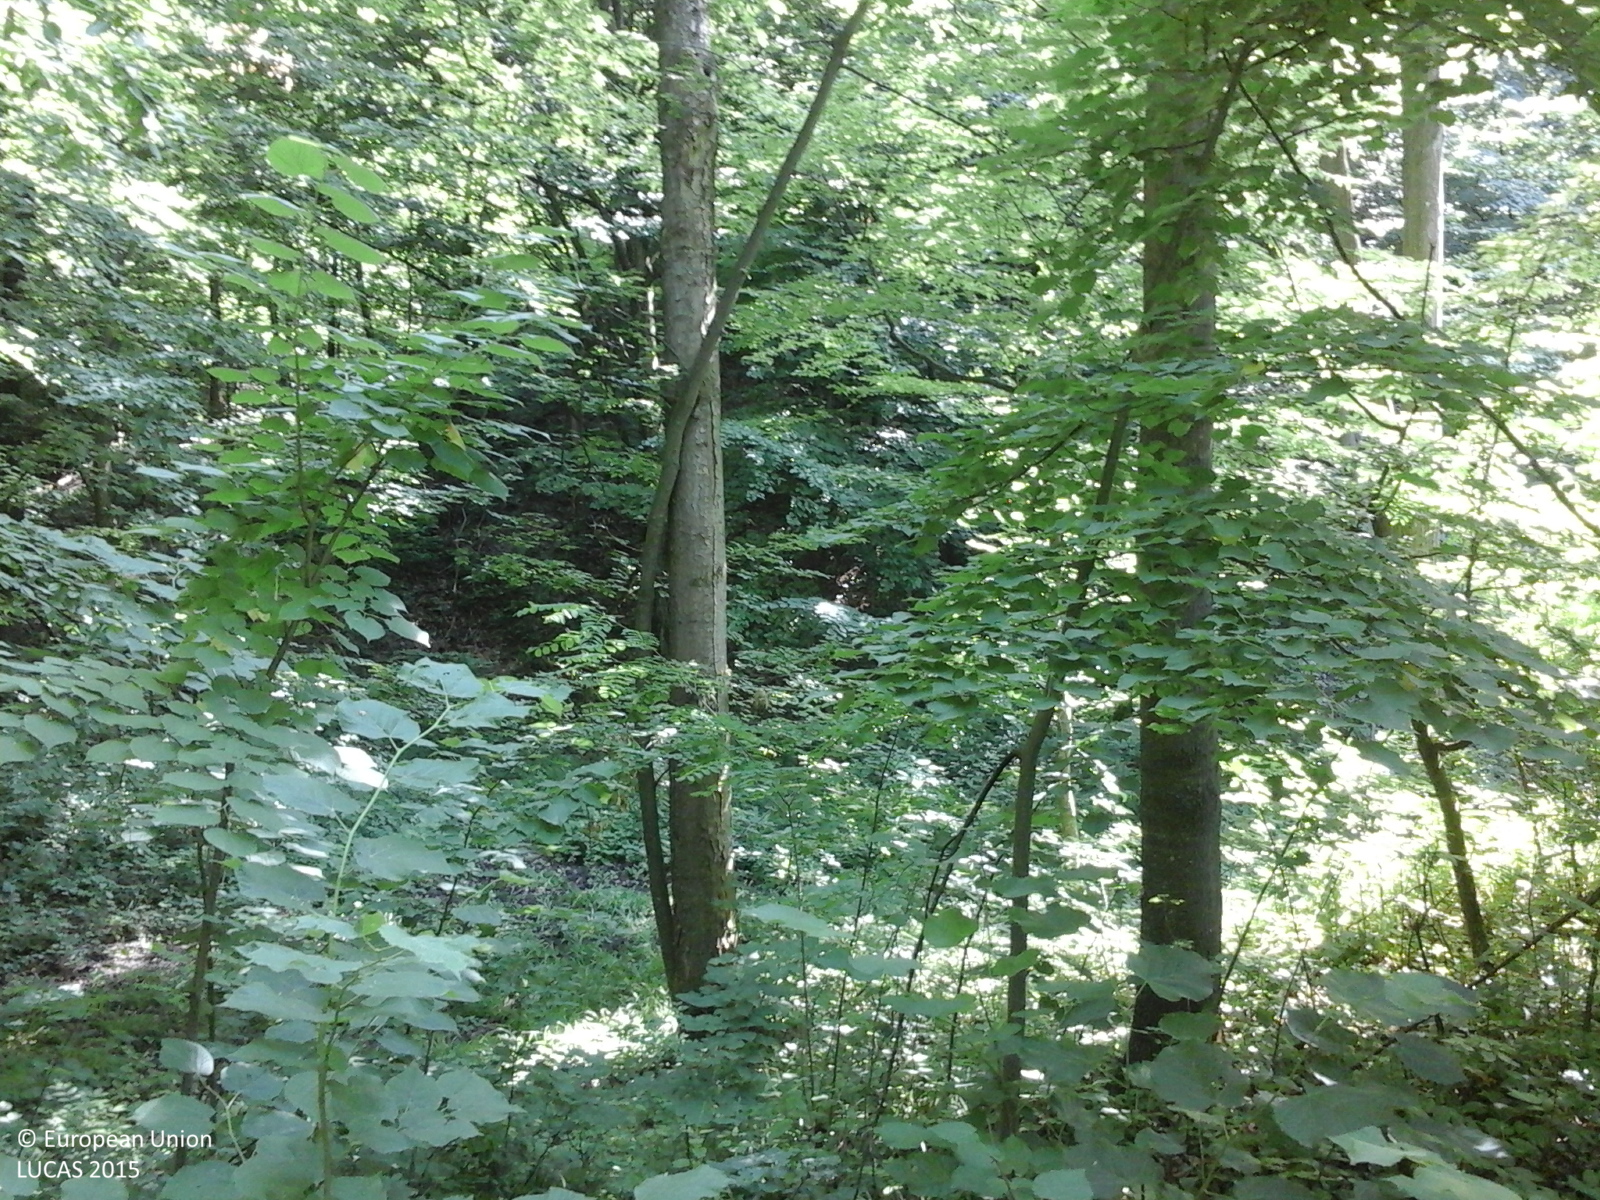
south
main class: Woodland
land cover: Broadleaved woodland
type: mesophytic deciduous forest
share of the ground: > 75 %
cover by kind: broadleaved forest trees 100 %
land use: Forestry
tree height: > 5 m
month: June
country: RO
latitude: 47.0176
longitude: 27.5743
